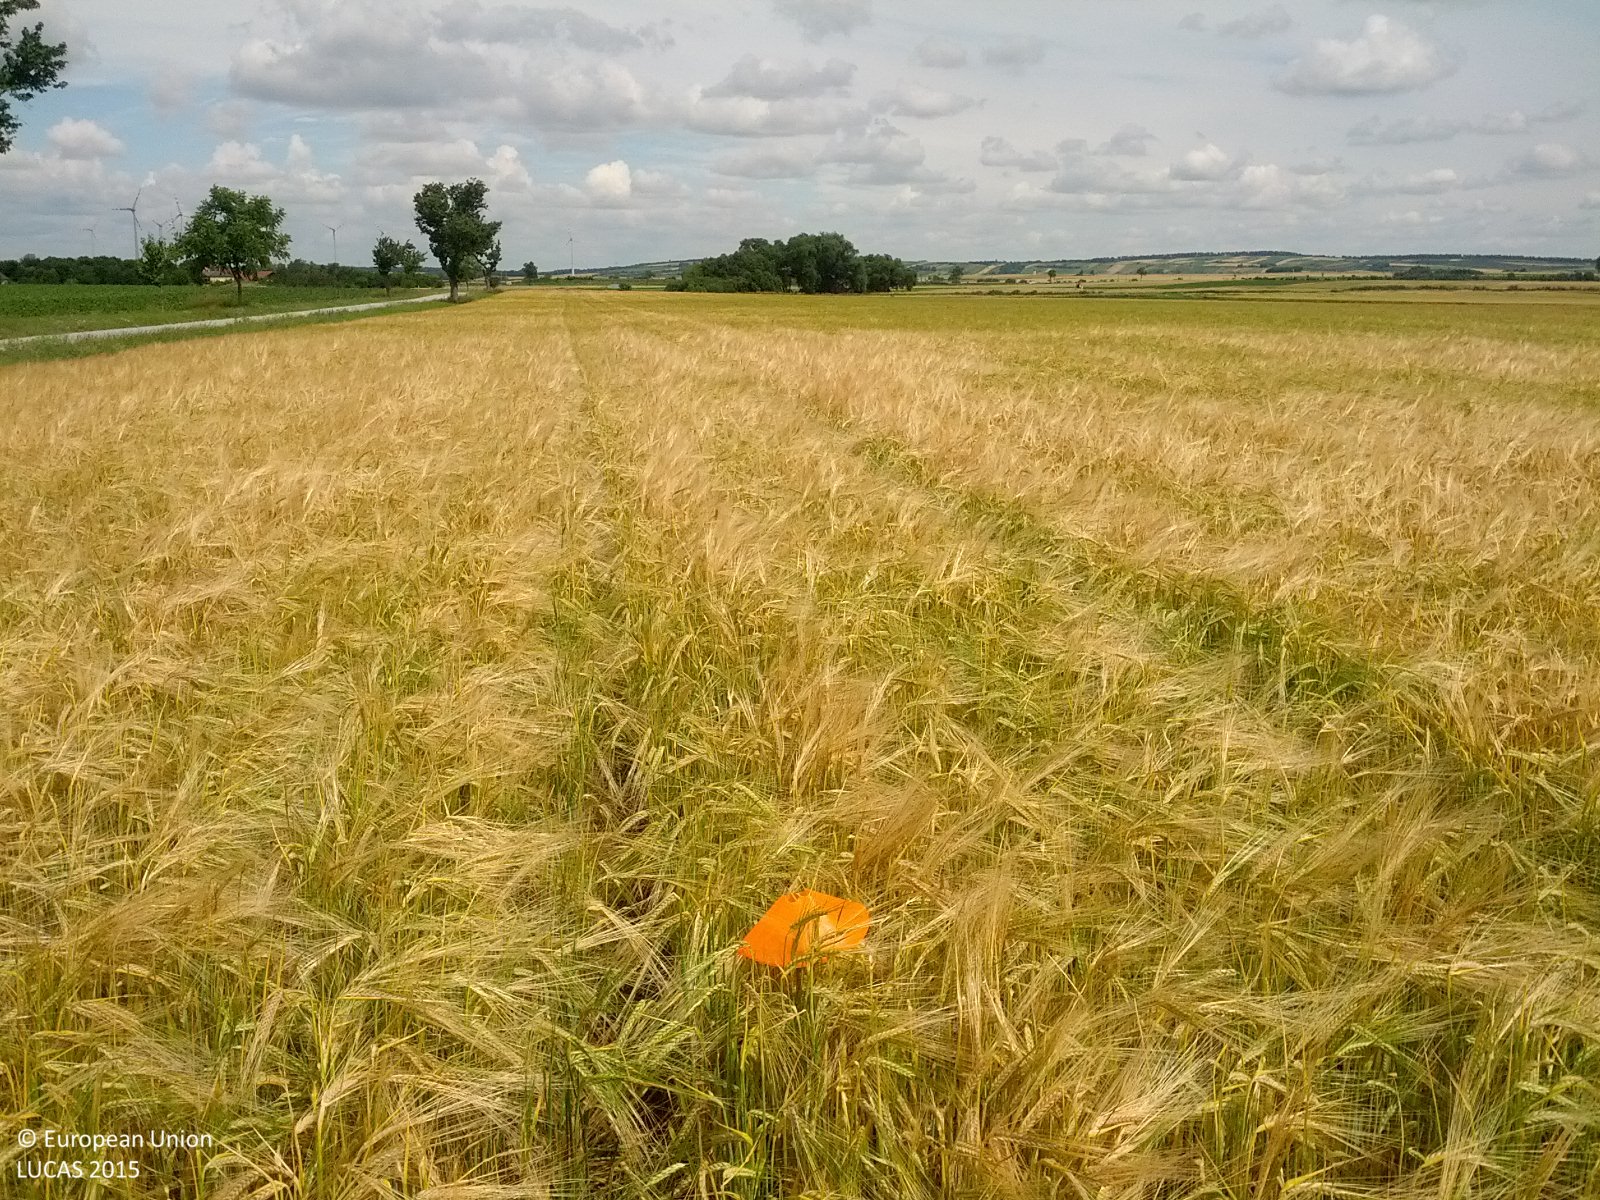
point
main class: Cropland
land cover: Barley
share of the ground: > 75 %
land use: Agriculture (excluding fallow land and kitchen gardens)
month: June
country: AT
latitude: 48.3569
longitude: 16.7953
